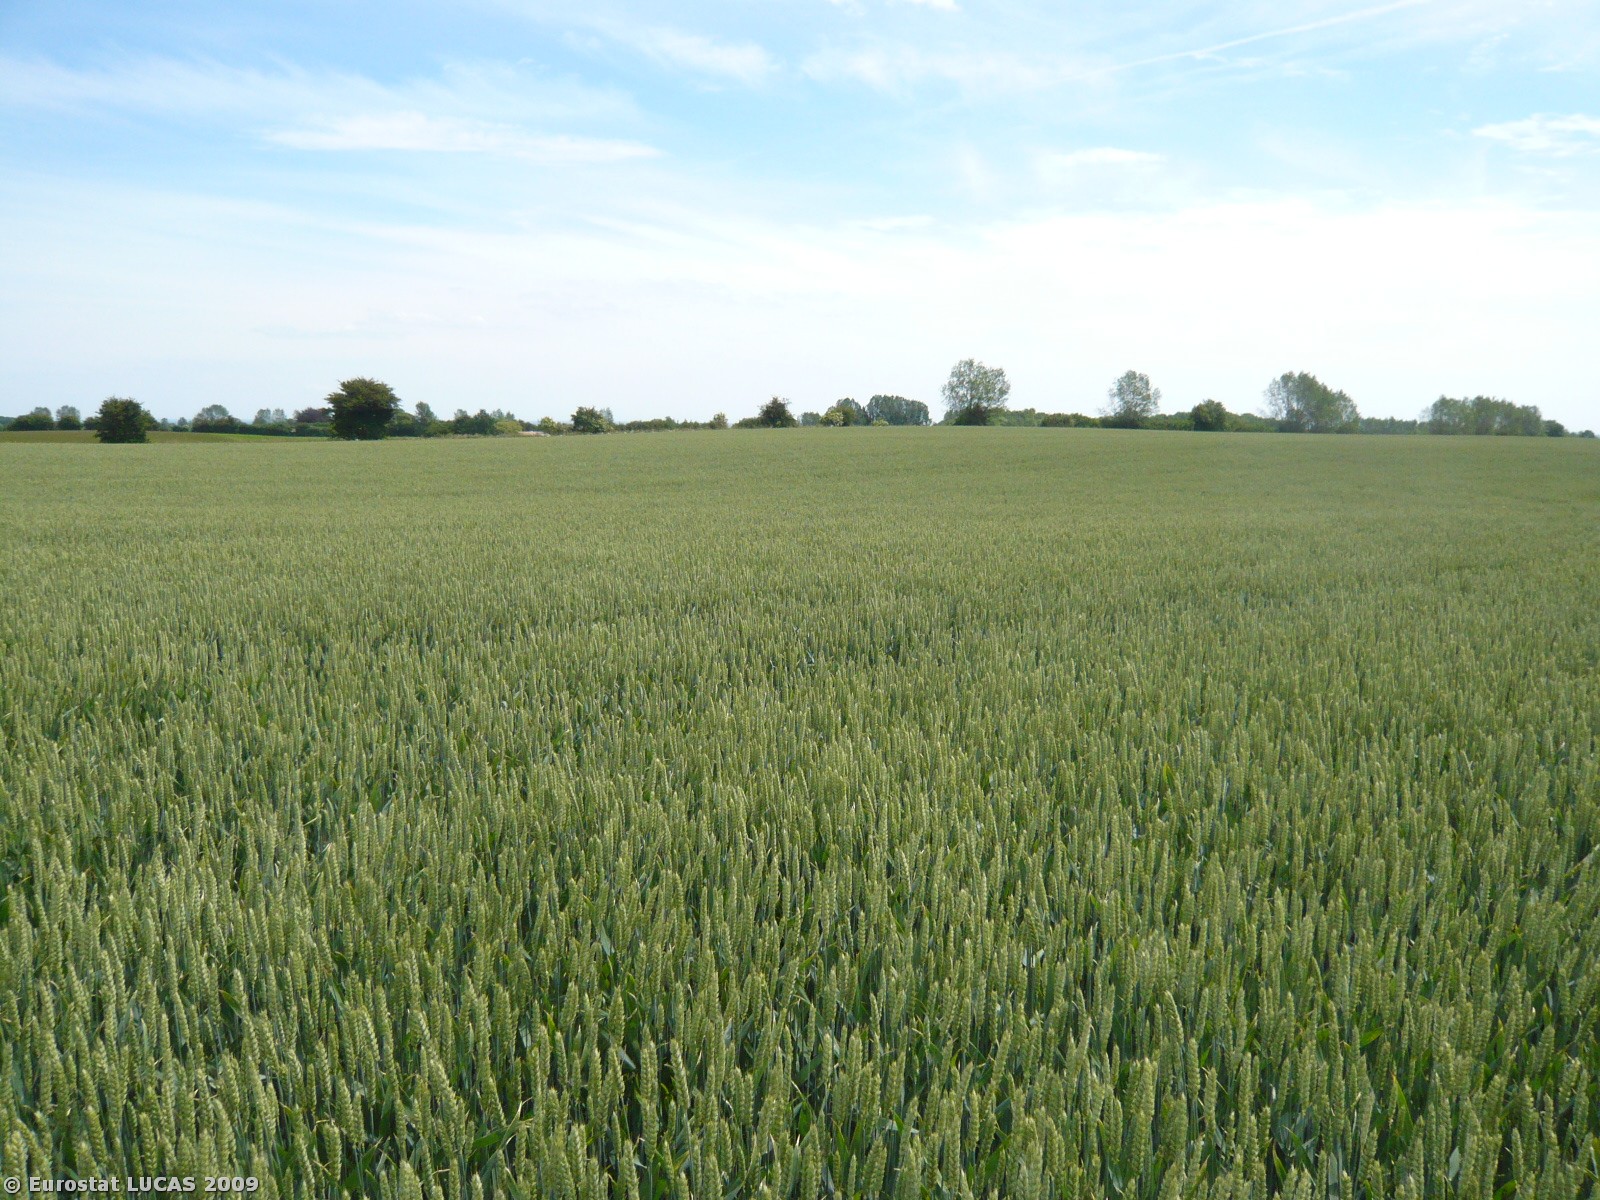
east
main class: Cropland
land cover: Common wheat
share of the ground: > 75 %
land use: Agriculture (excluding fallow land and kitchen gardens)
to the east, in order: Common wheat; Shrubland with sparse tree cover; Grassland without tree/shrub cover
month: June
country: DK
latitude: 55.1968
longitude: 10.7691
